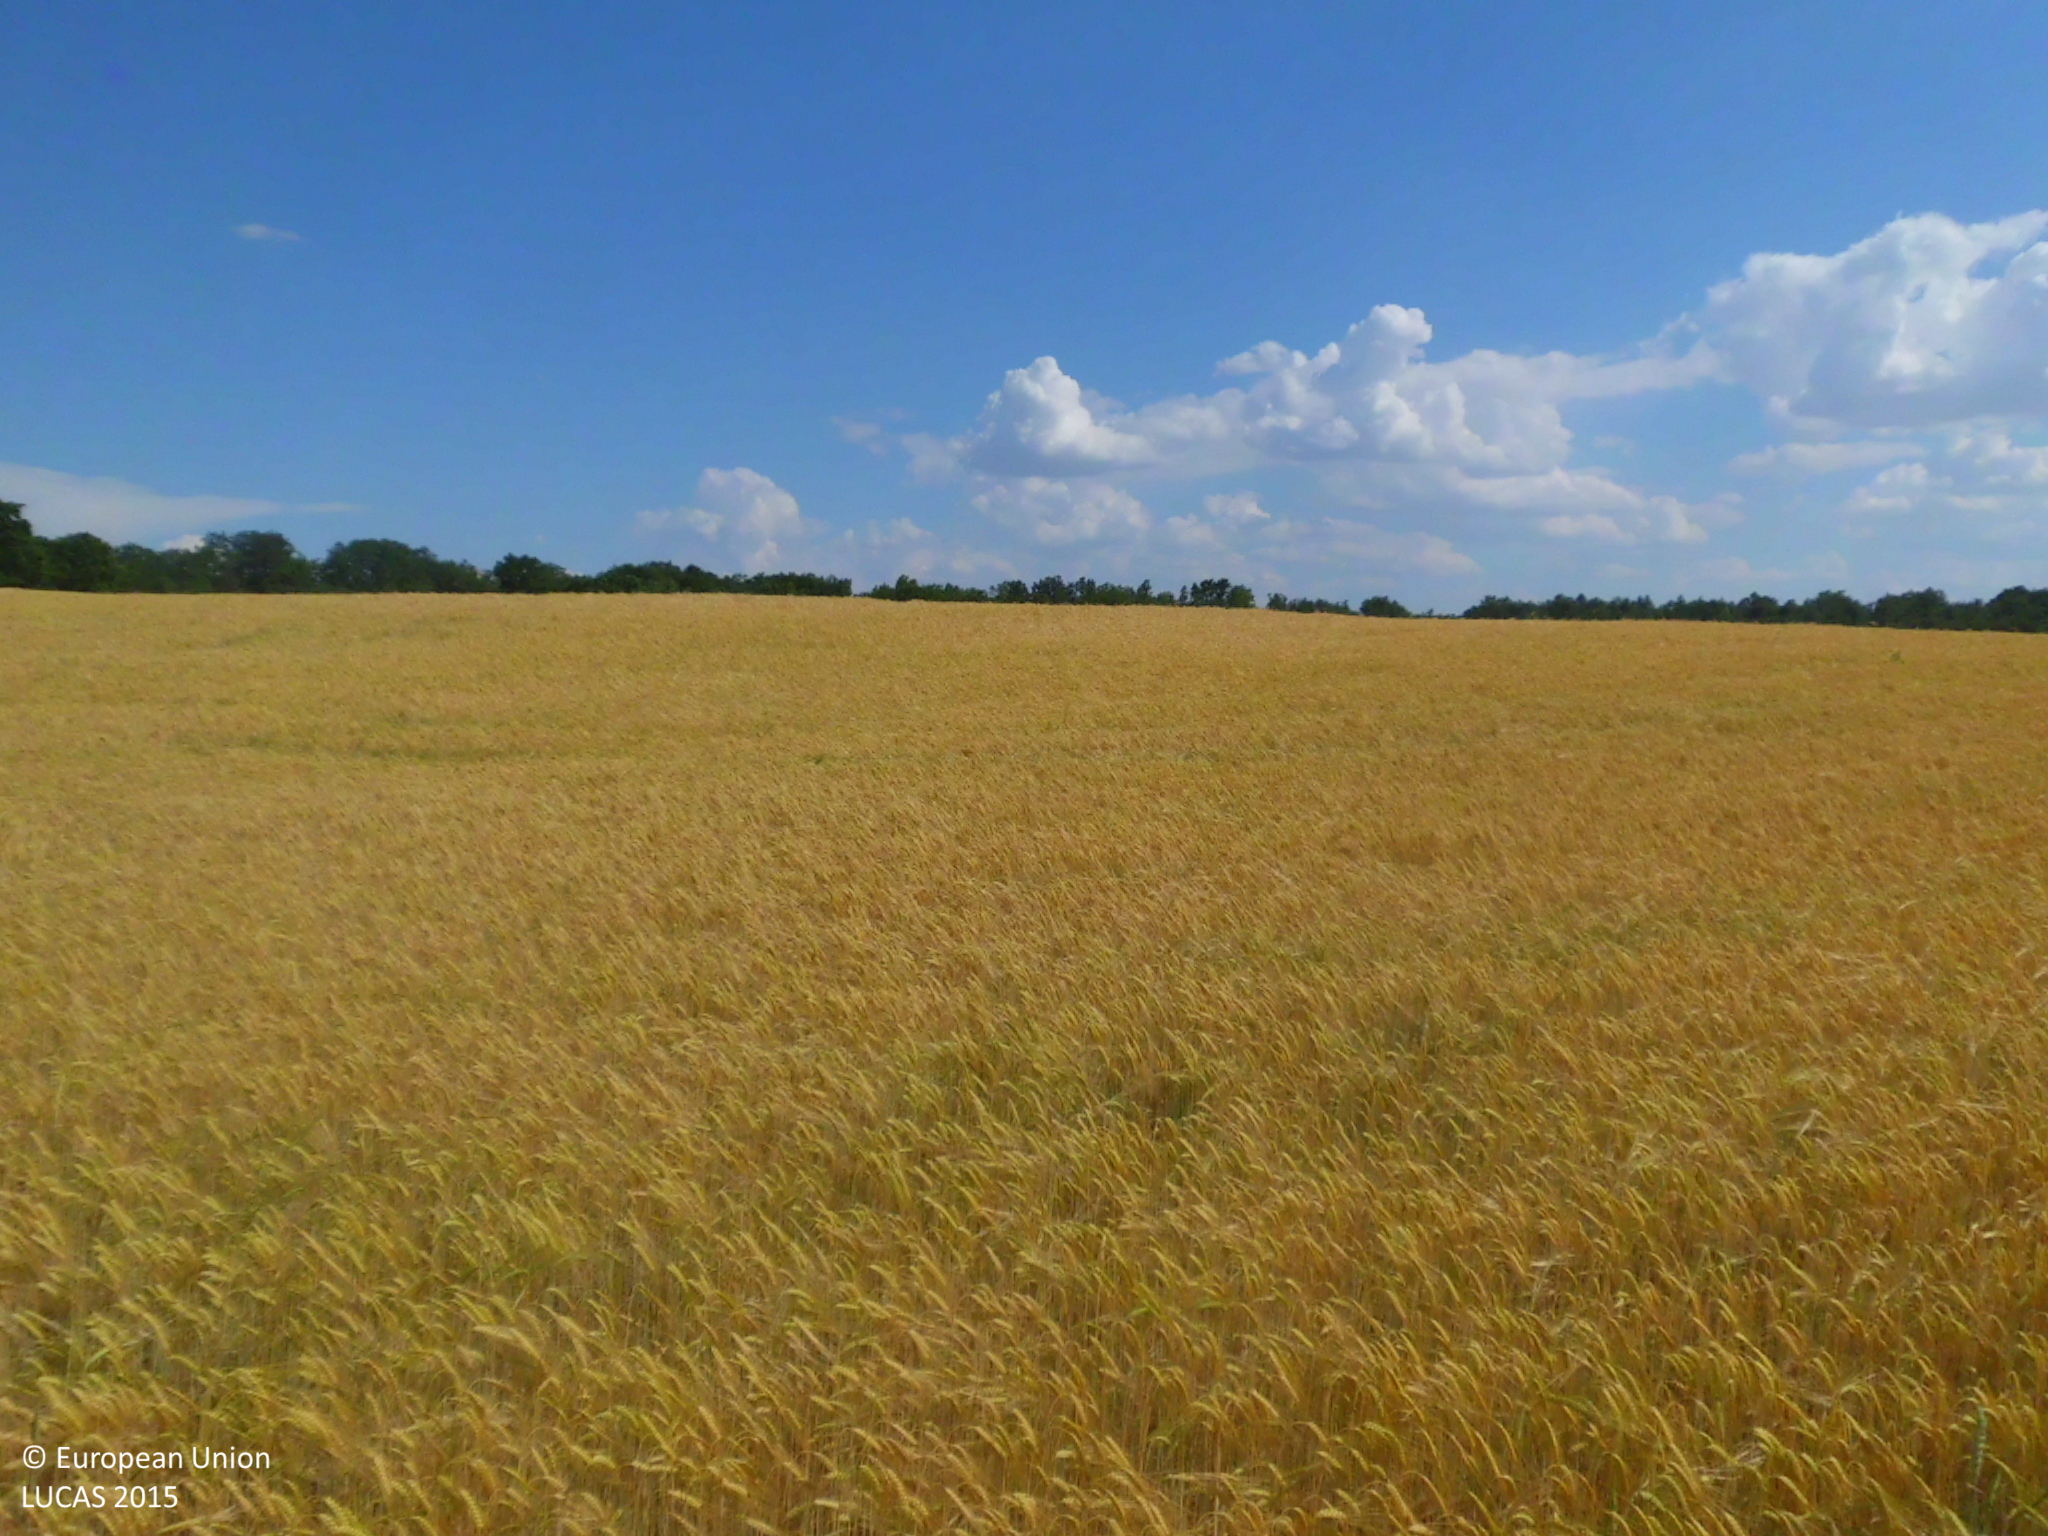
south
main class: Cropland
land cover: Barley
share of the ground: > 75 %
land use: Agriculture (excluding fallow land and kitchen gardens)
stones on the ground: < 10 %
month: June
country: ES
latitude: 42.5232
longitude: -4.3520
